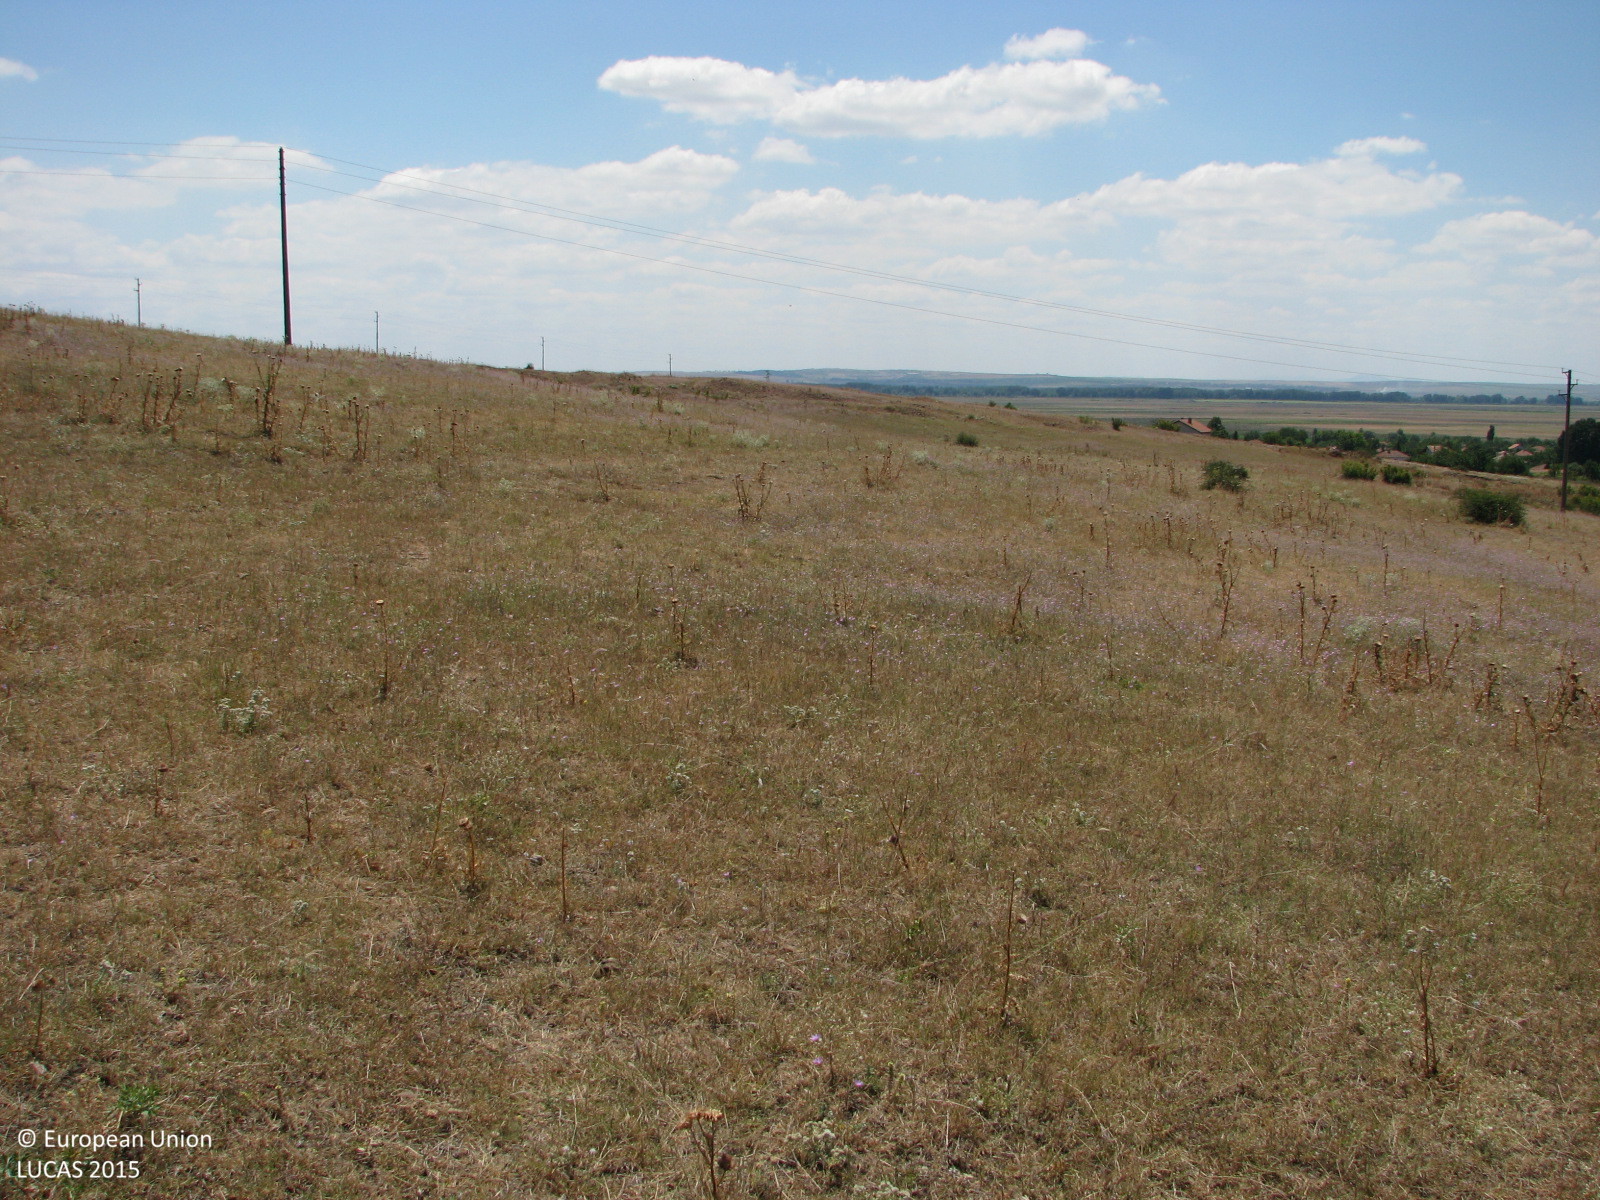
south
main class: Grassland
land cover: Grassland without tree/shrub cover
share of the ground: > 75 %
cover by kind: herbaceous plants 90 %, unconsolidated bare surface 10 %
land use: Semi-natural and natural areas not in use
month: July
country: BG
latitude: 42.6099
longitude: 26.4139
